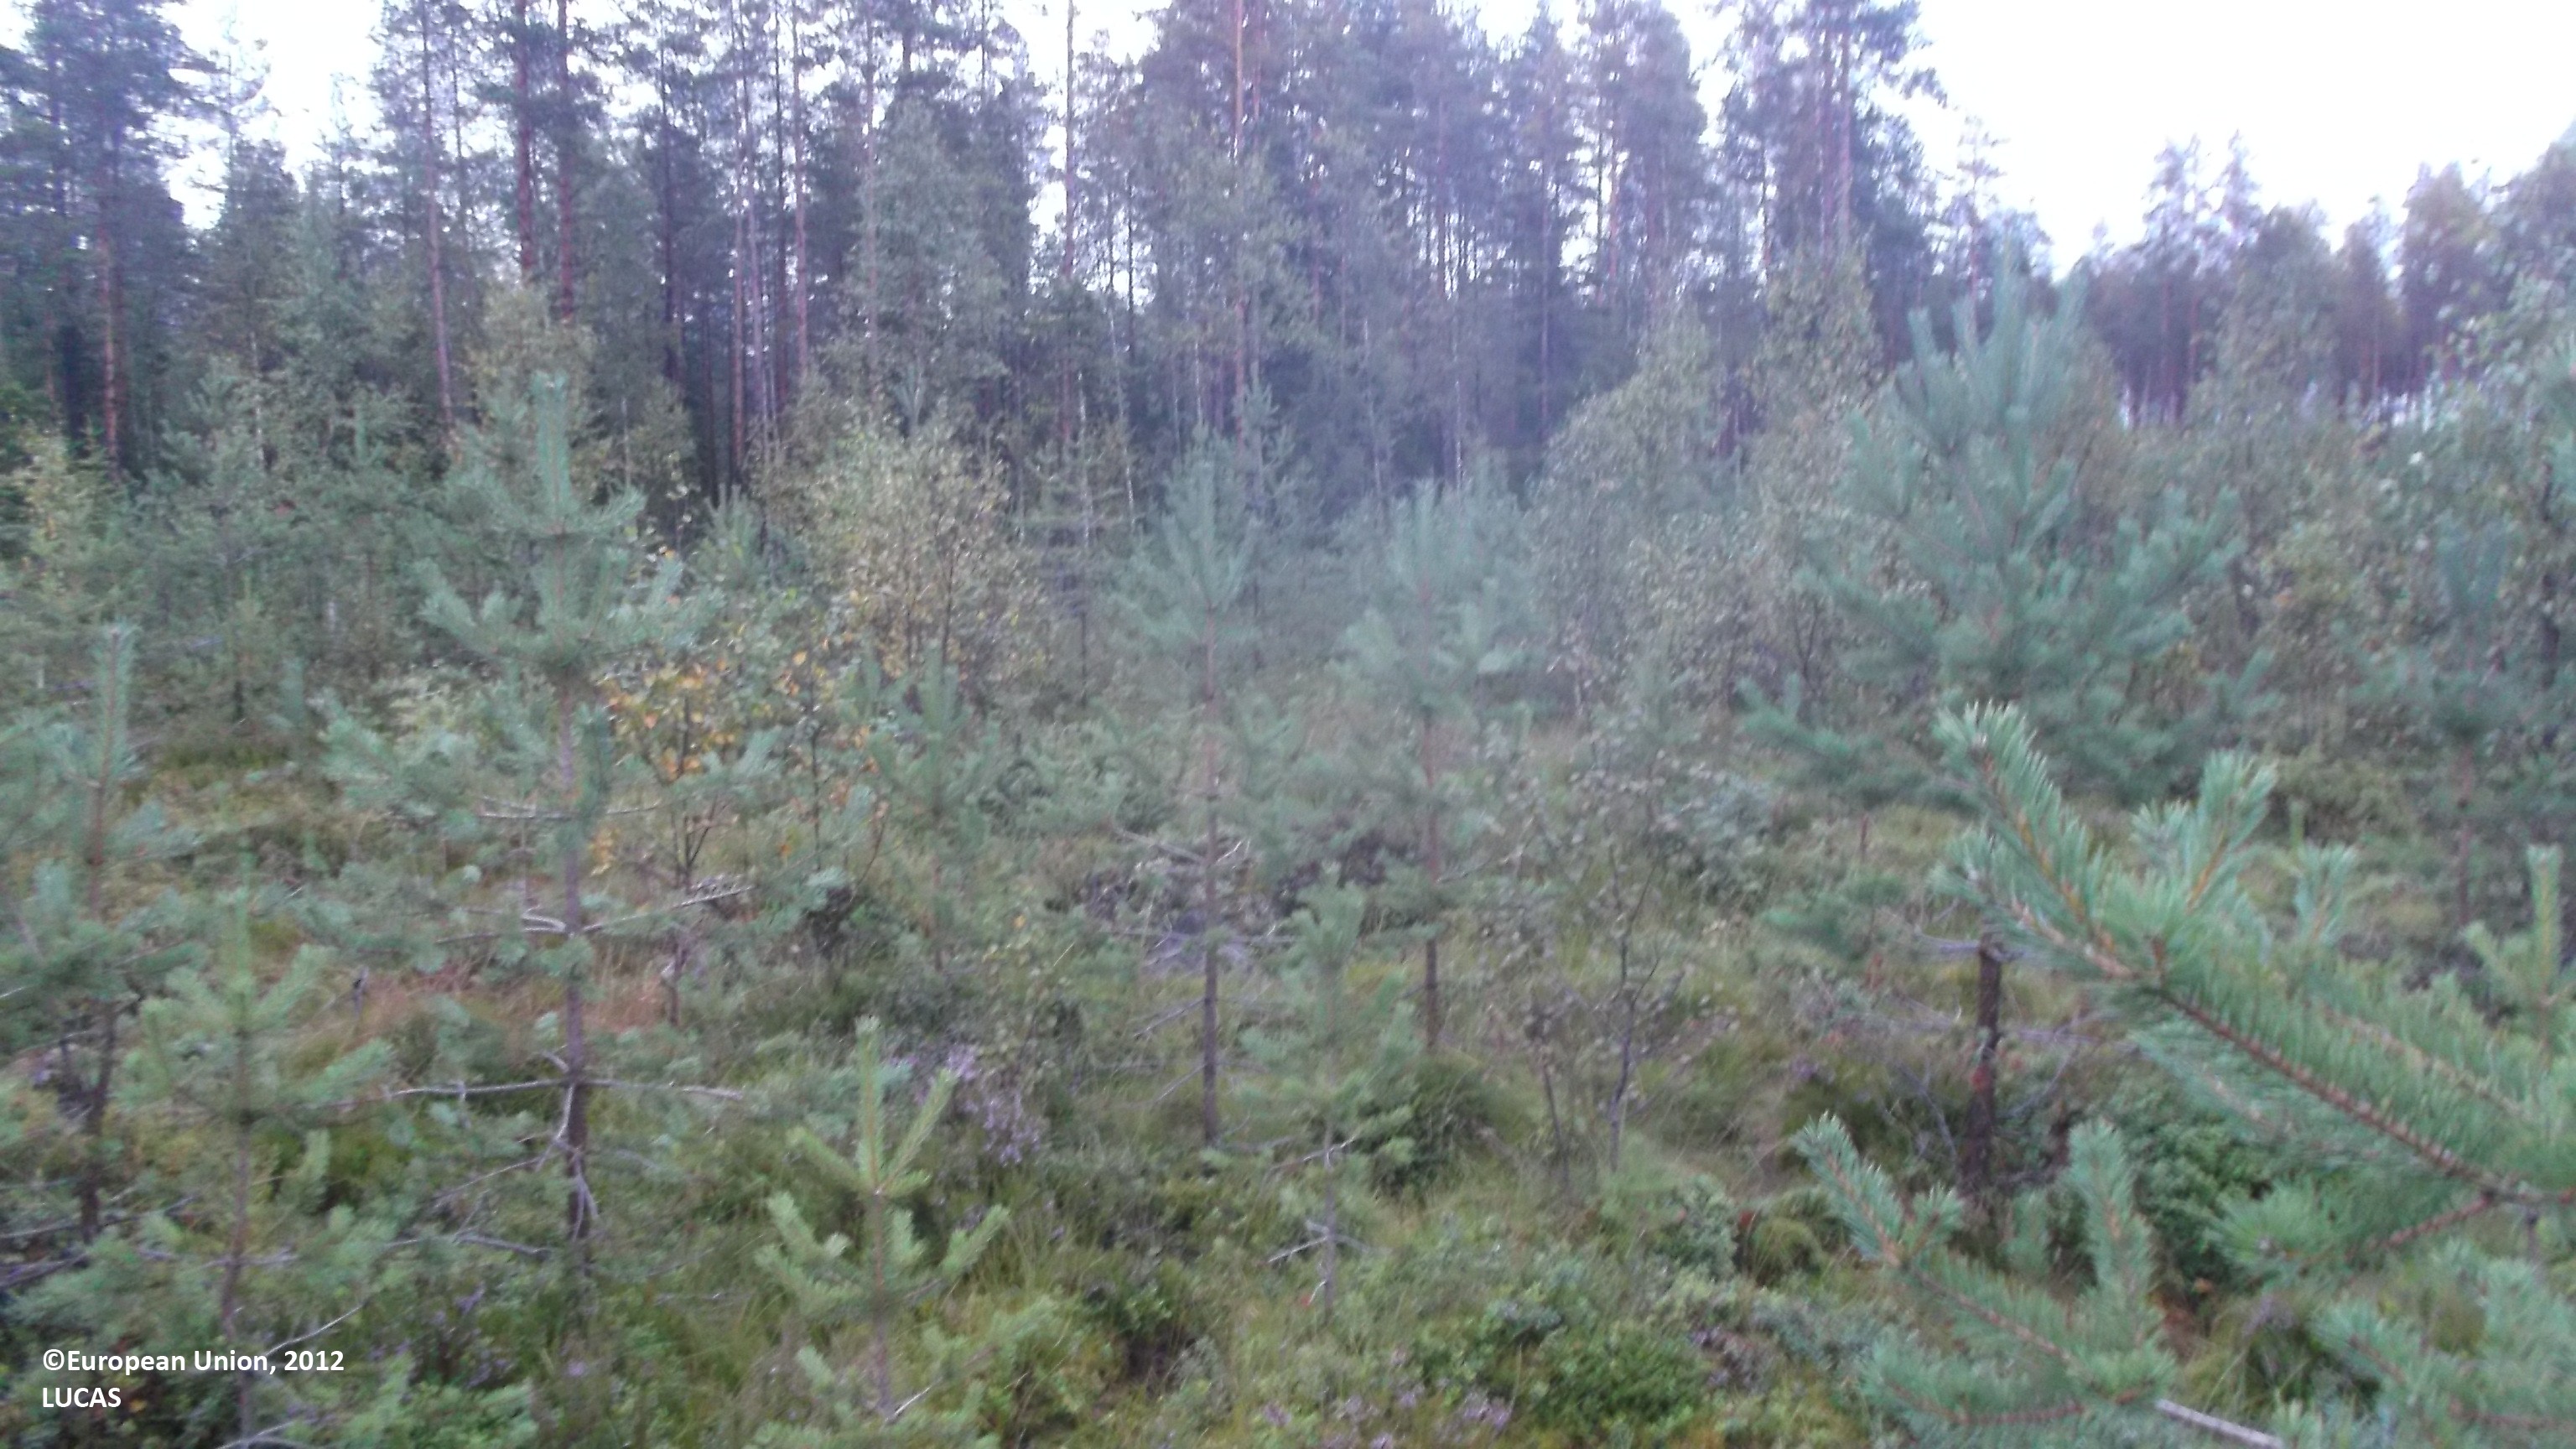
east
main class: Woodland
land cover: Other mixed woodland
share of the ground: < 10 %
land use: Forestry
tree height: < 5 m
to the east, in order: Other mixed woodland; Rivers and streams; Pine dominated coniferous woodland
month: August
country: FI
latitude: 63.1976
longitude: 24.4539
